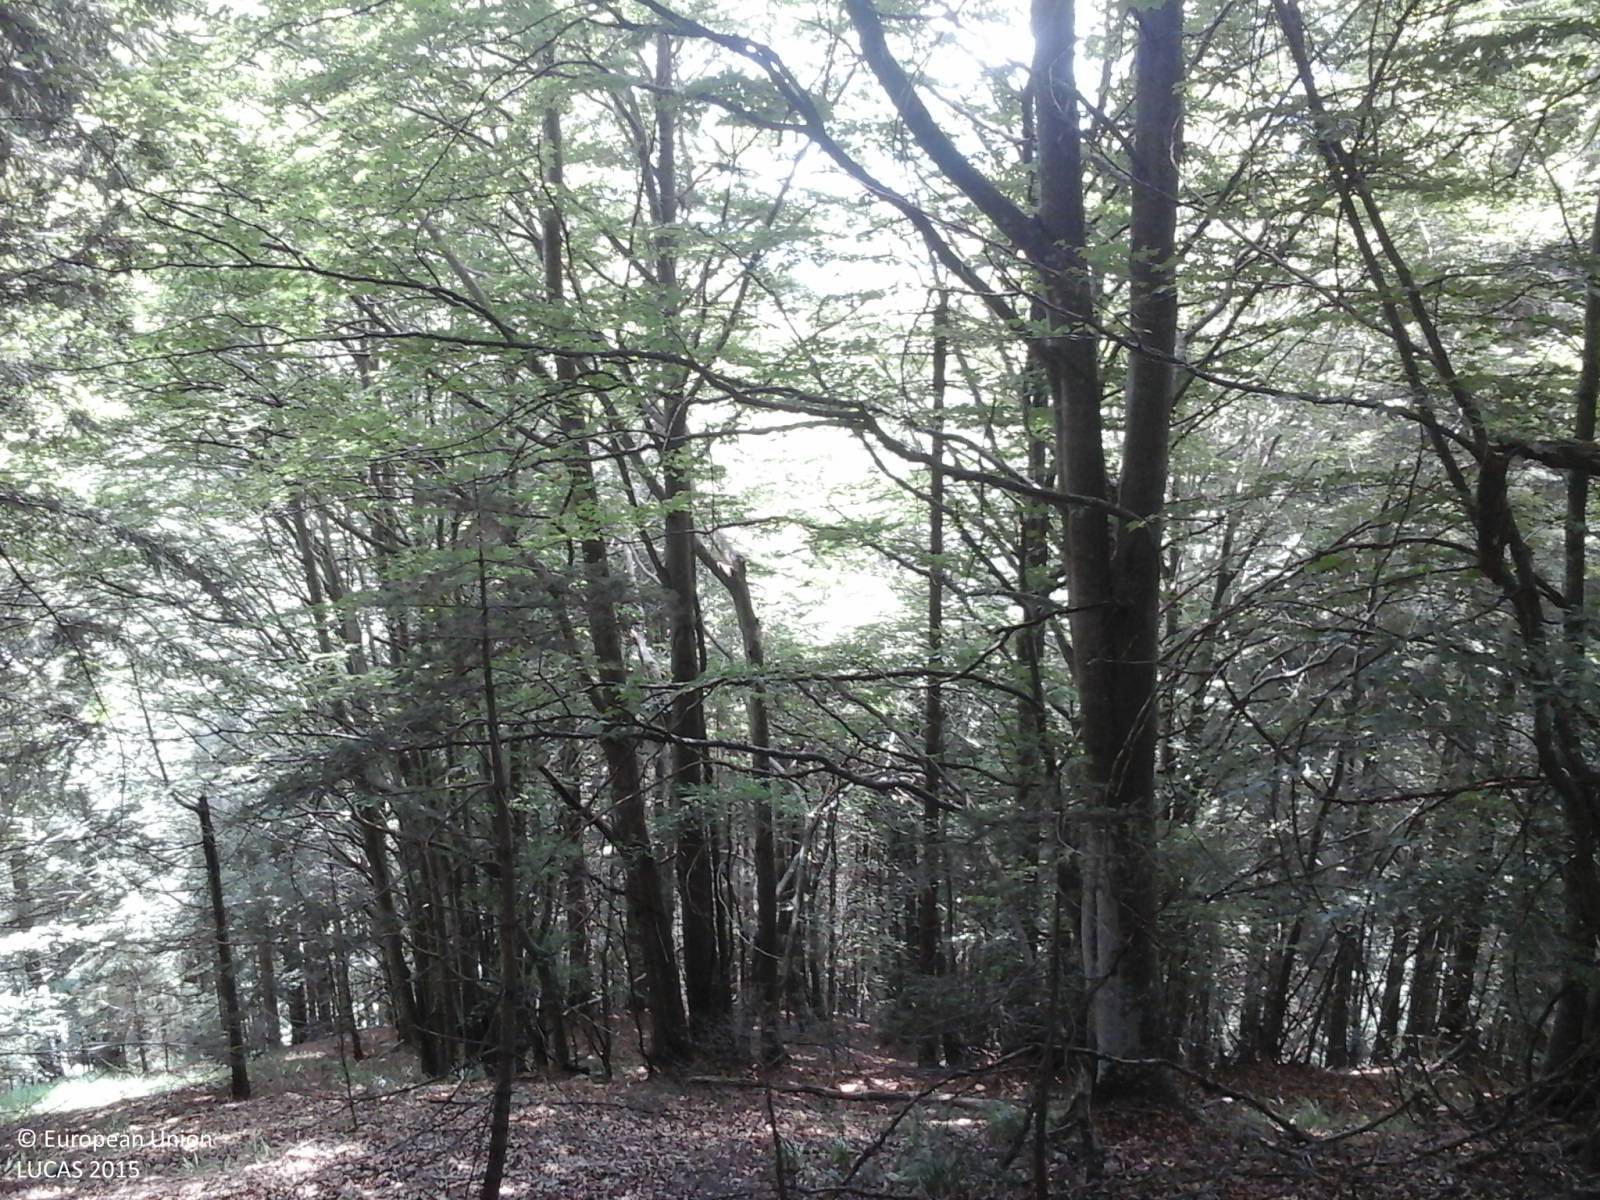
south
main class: Woodland
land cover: Other mixed woodland
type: alpine coniferous forest
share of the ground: > 75 %
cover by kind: coniferous forest trees 50 %, broadleaved forest trees 50 %
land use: Forestry
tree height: > 5 m
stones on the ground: < 10 %
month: July
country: IT
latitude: 46.5439
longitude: 12.9835
